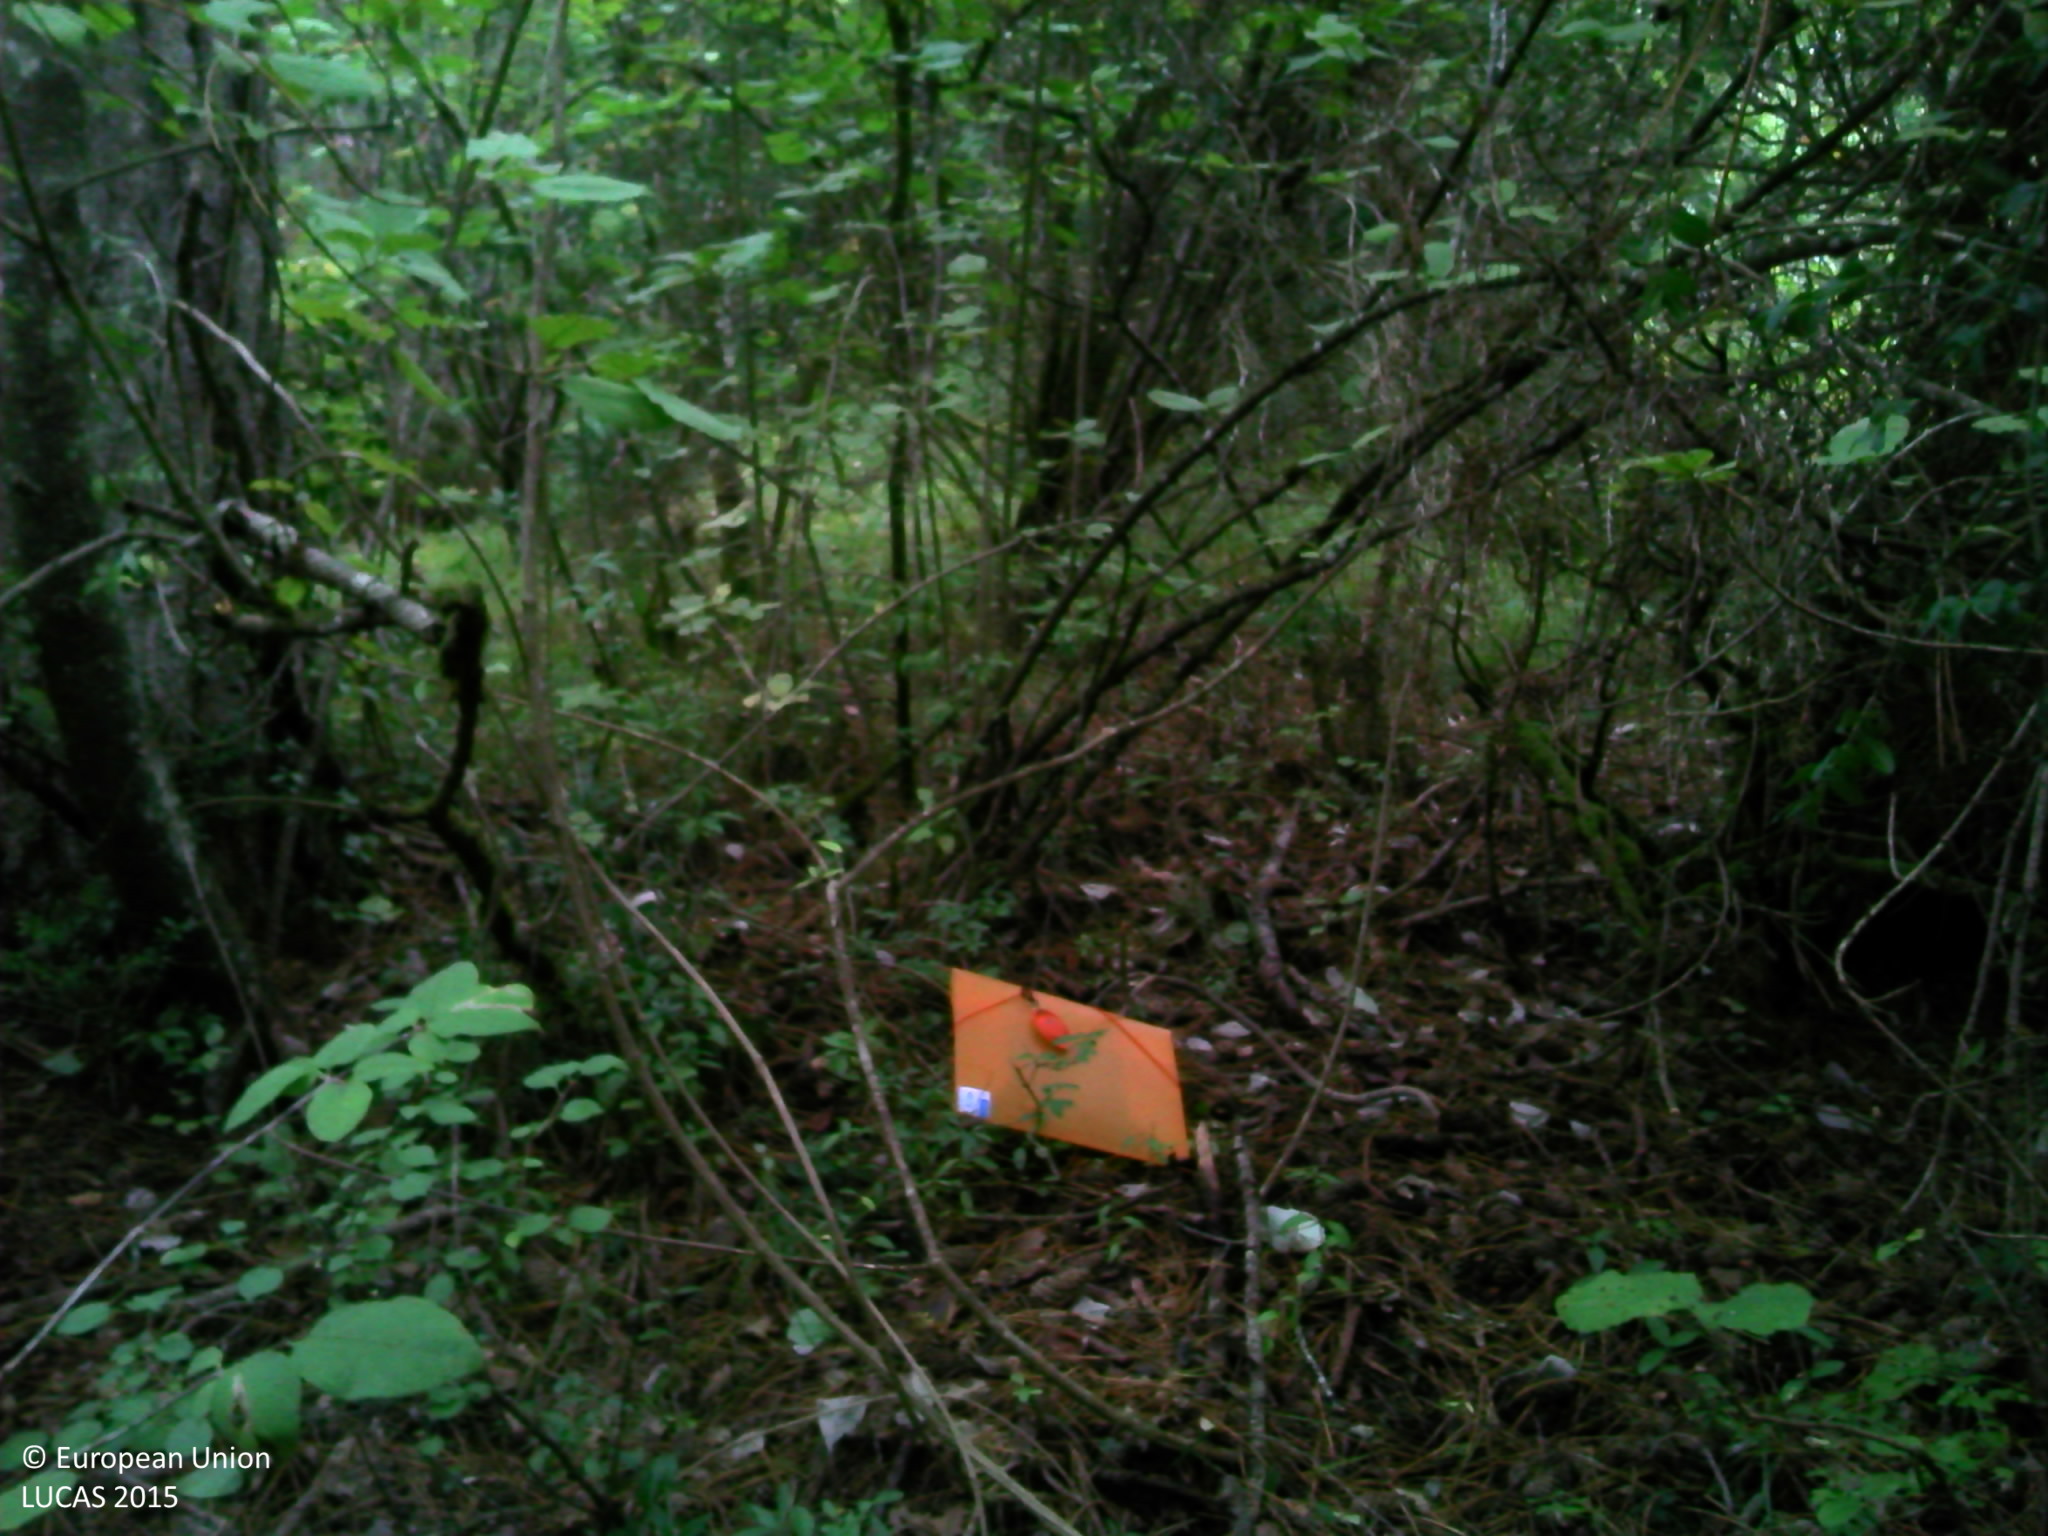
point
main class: Woodland
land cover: Pine dominated mixed woodland
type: hemiboreal forest and nemoral coniferous forest and mixed broadleaved-coniferous forest
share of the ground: > 75 %
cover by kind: coniferous forest trees 70 %, broadleaved forest trees 25 %, shrubs 5 %
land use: Forestry
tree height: > 5 m
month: September
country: FR
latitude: 47.0151
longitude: 4.7255
